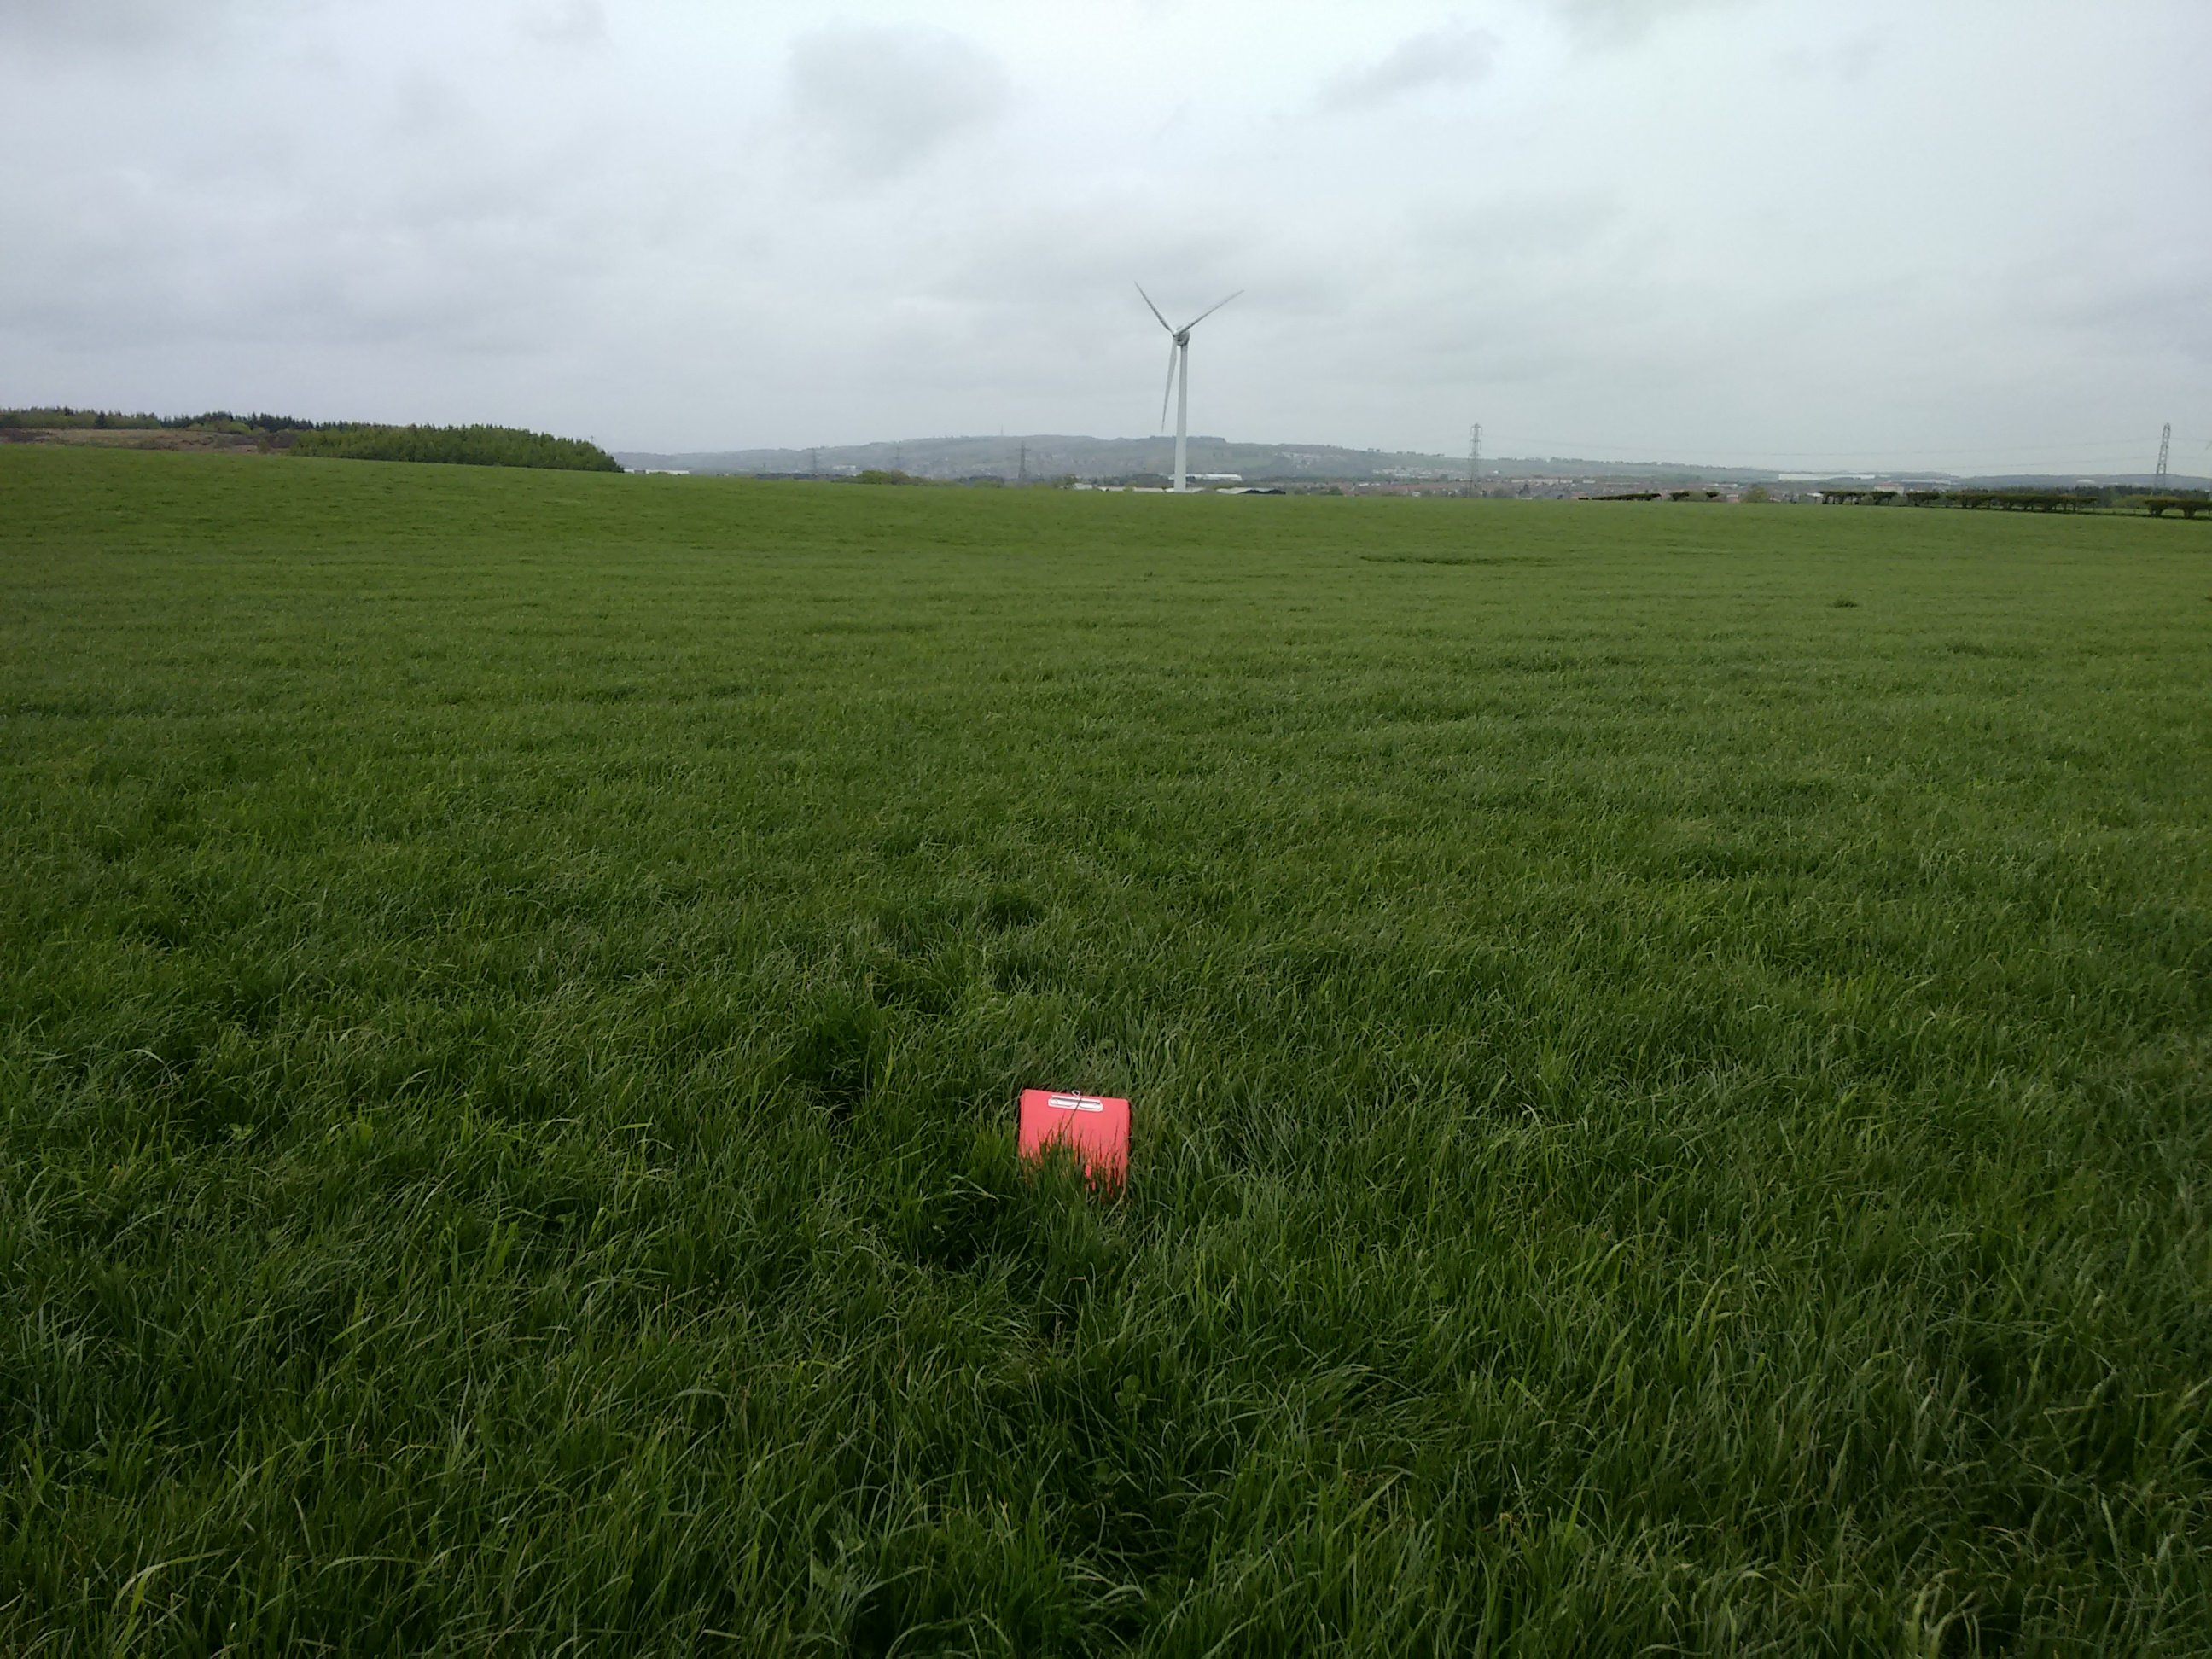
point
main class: Grassland
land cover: Grassland without tree/shrub cover
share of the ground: > 75 %
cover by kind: herbaceous plants 100 %
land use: Agriculture (excluding fallow land and kitchen gardens)
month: May
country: GB
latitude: 55.8562
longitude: -3.6437
